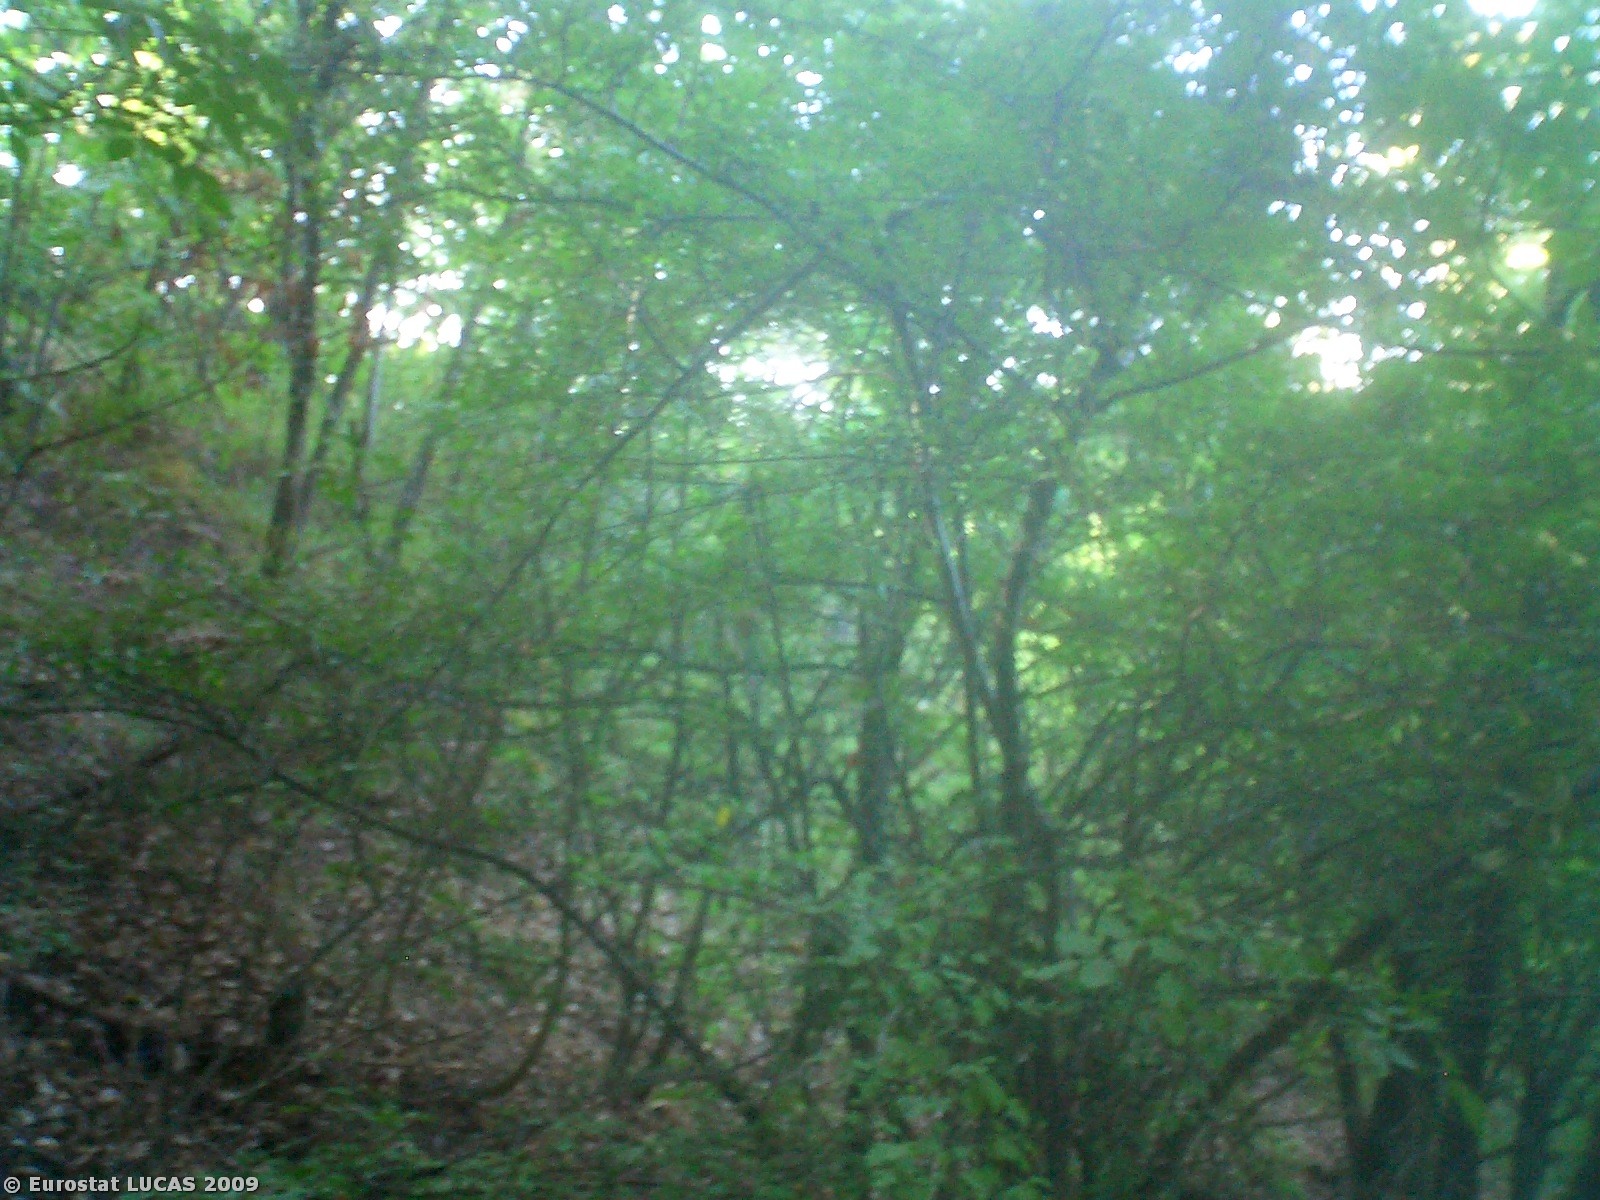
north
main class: Woodland
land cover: Mixed woodland
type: mesophytic deciduous forest
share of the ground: > 75 %
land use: Forestry
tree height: > 5 m
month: July
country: IT
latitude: 44.2655
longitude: 11.6373
